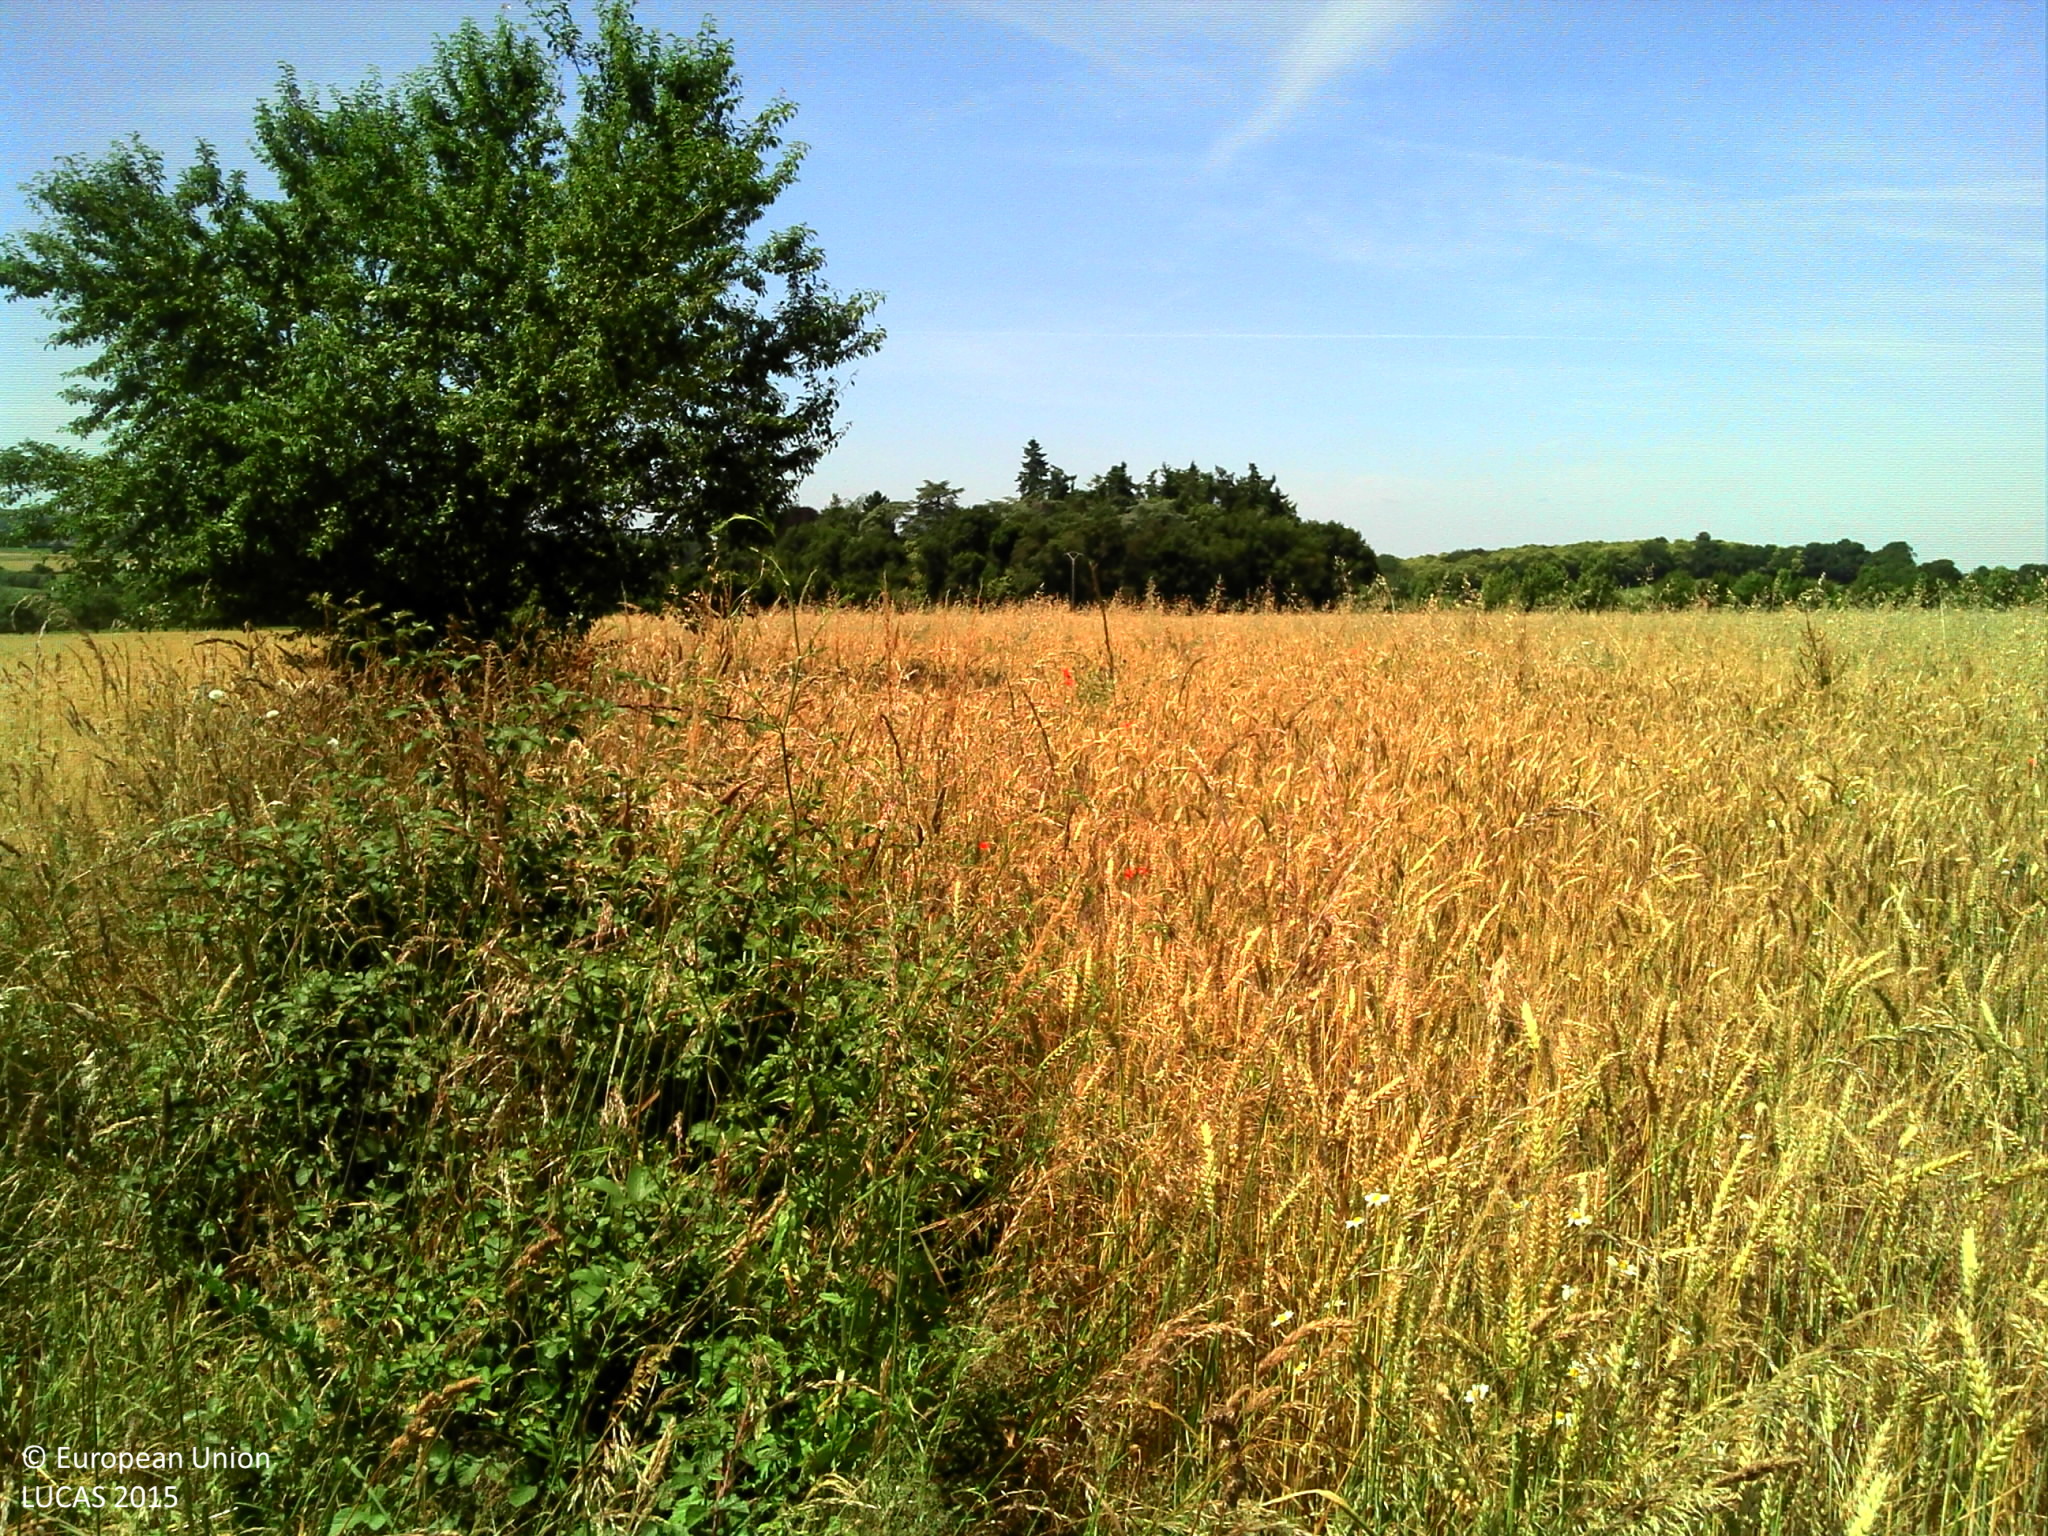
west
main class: Cropland
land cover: Common wheat
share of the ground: > 75 %
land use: Agriculture (excluding fallow land and kitchen gardens)
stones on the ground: < 10 %
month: June
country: FR
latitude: 48.0072
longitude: -1.6147
